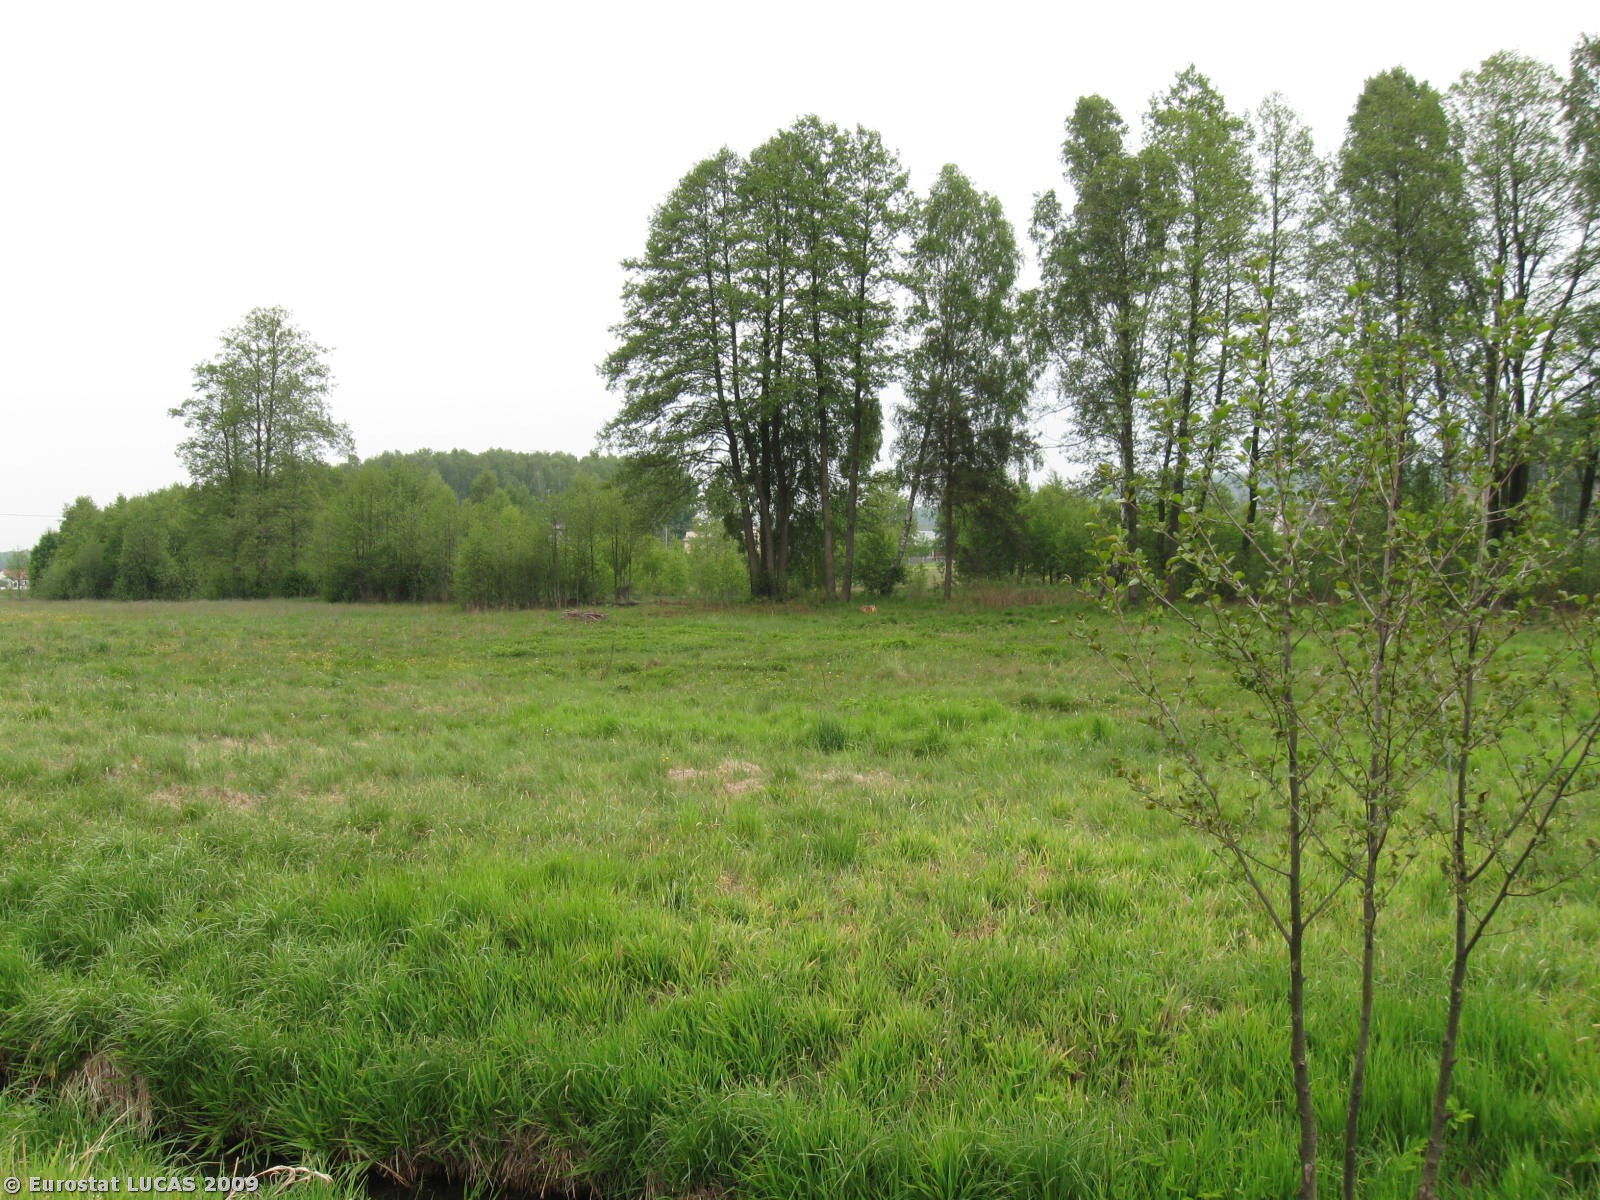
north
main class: Grassland
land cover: Grassland without tree/shrub cover
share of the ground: > 75 %
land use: Agriculture (excluding fallow land and kitchen gardens)
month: May
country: PL
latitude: 50.9570
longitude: 20.4157
